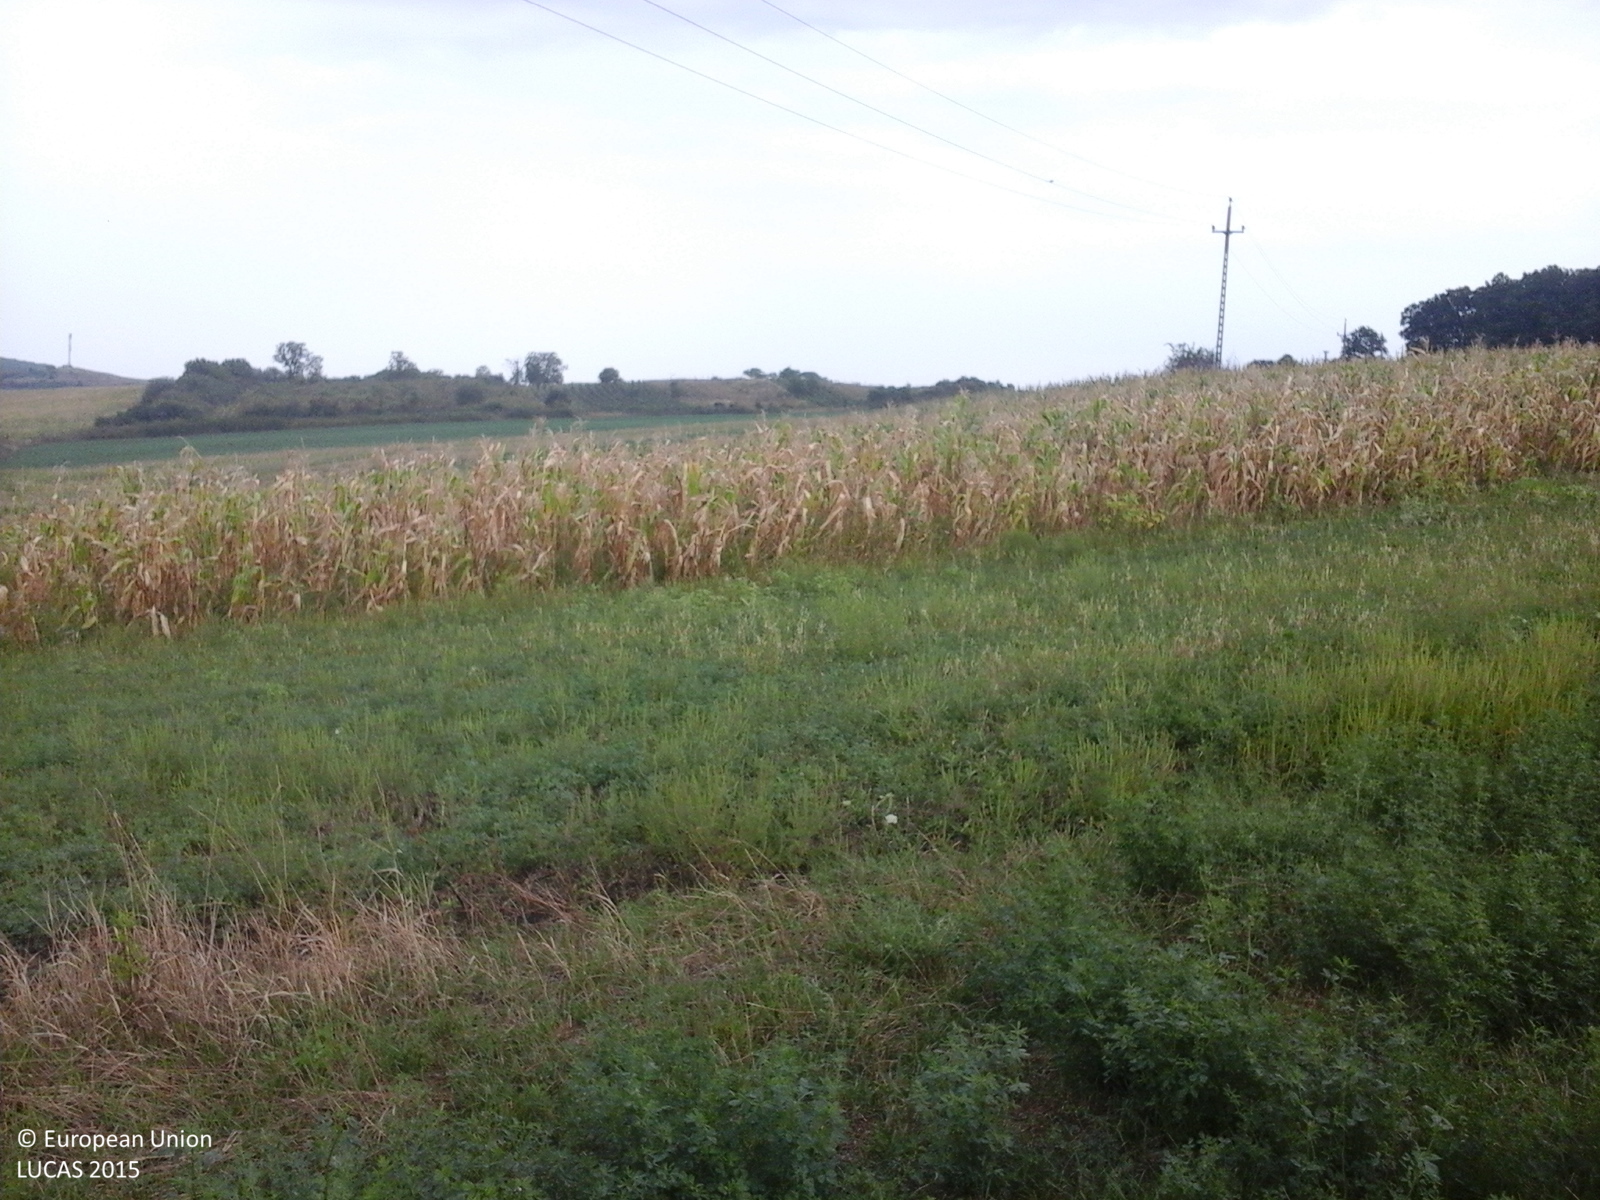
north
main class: Cropland
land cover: Lucerne
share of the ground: > 75 %
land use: Agriculture (excluding fallow land and kitchen gardens)
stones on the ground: < 10 %
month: September
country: RO
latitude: 47.2191
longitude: 23.0986
